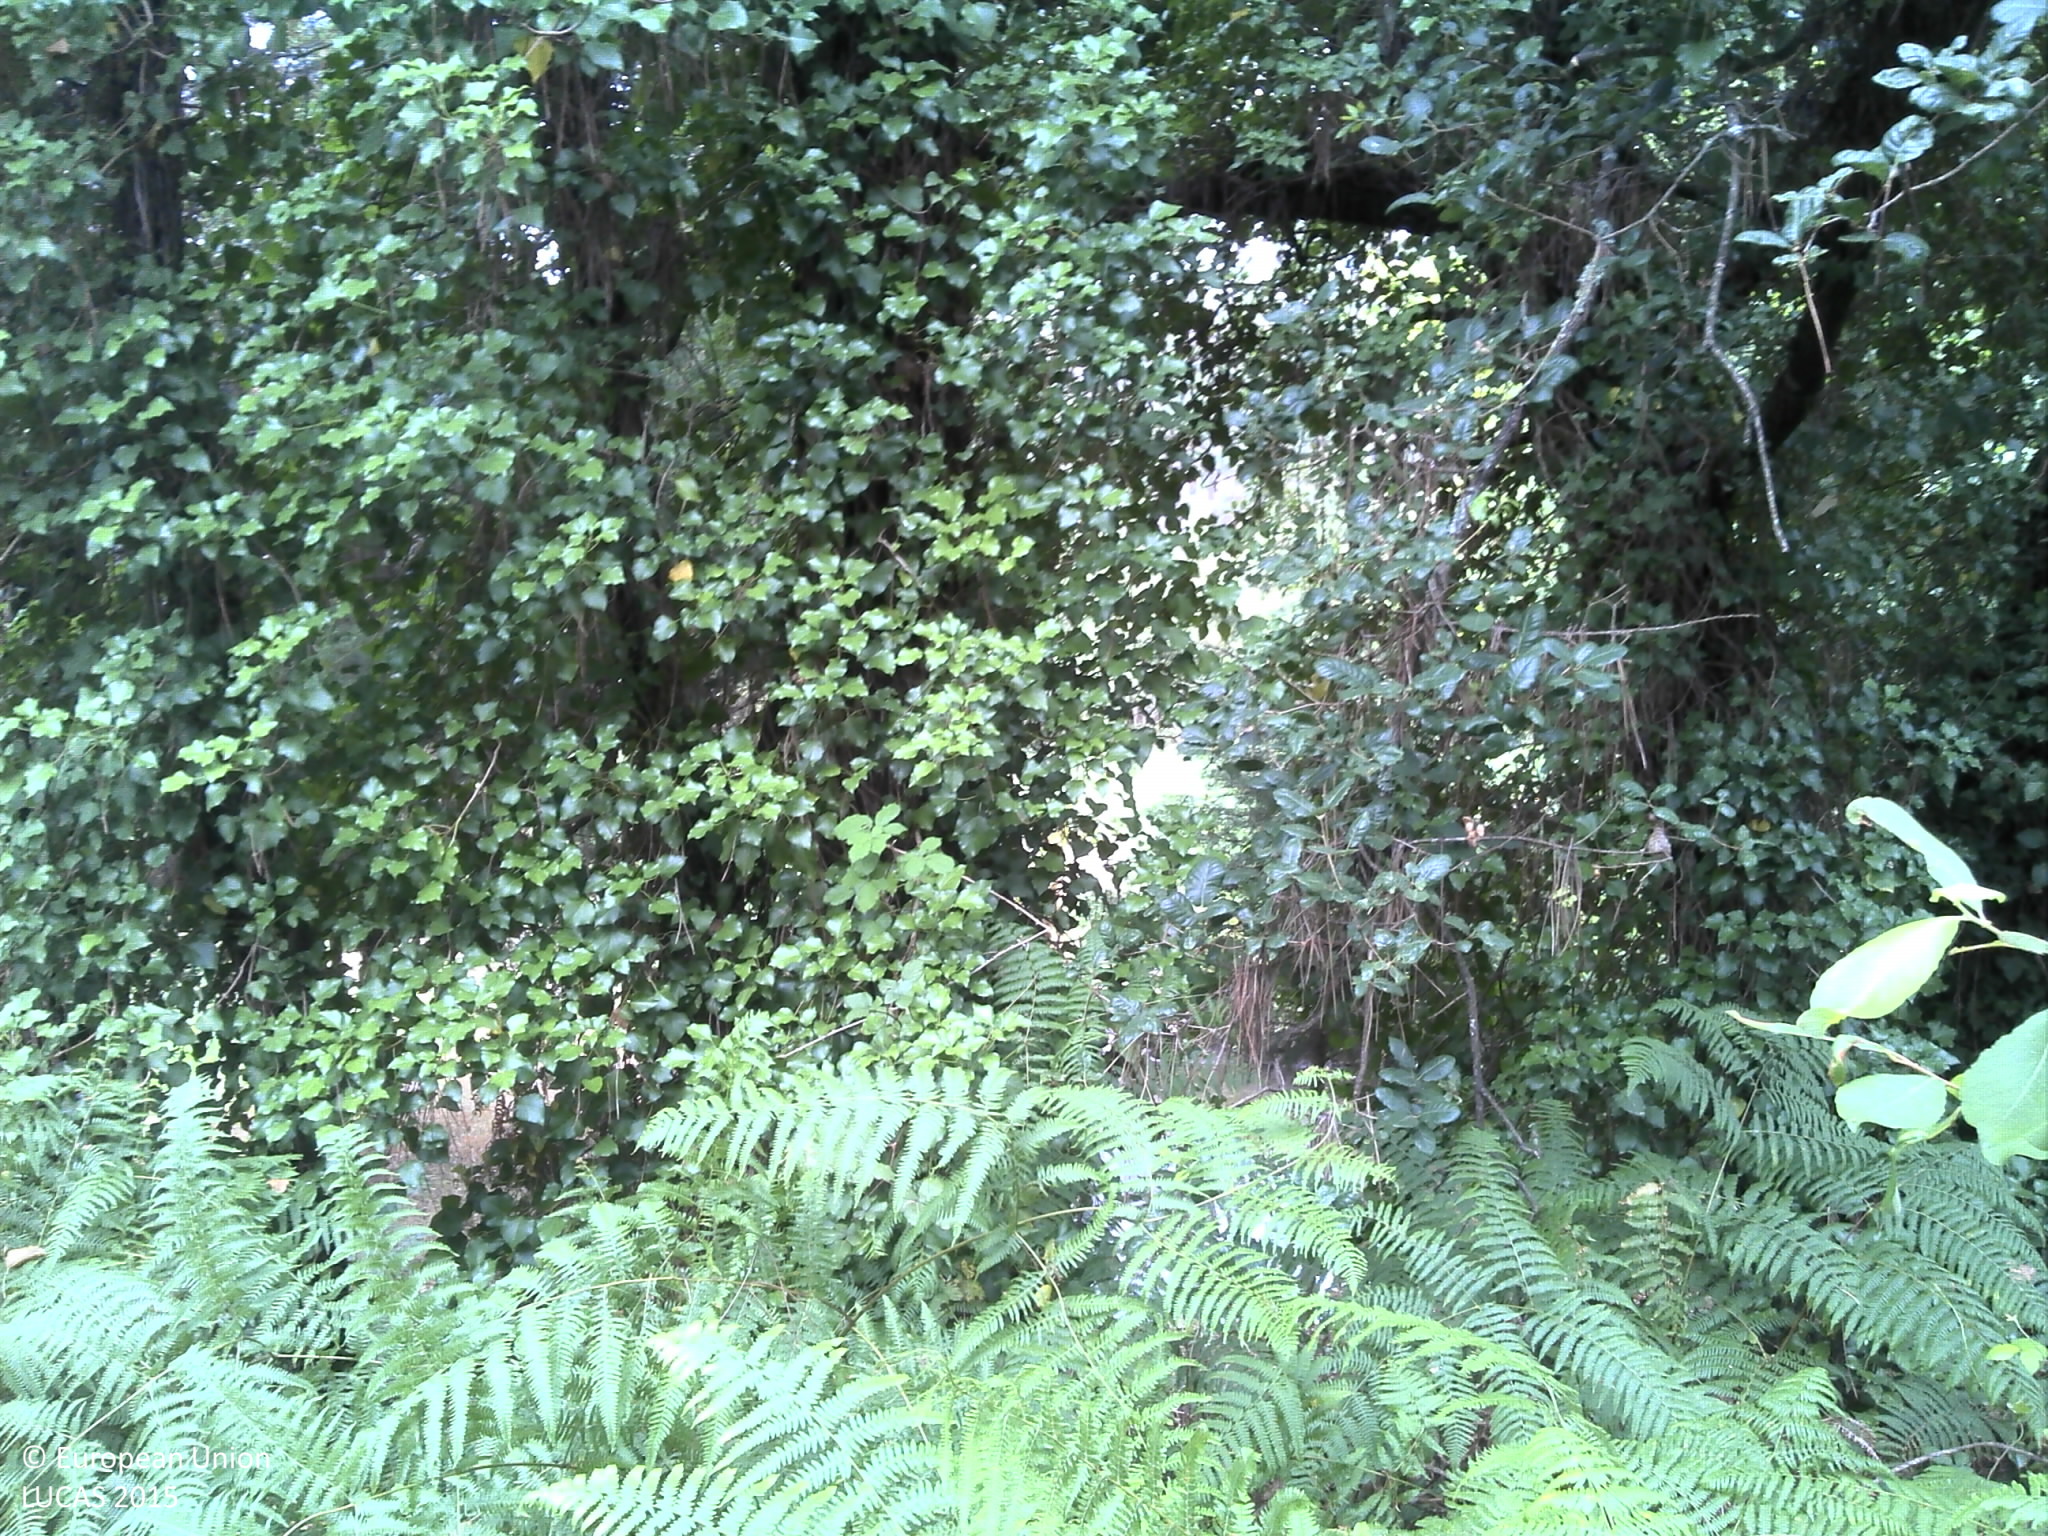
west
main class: Woodland
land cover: Pine dominated coniferous woodland
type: coniferous forest of the mediterranean region
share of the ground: 50 - 75 %
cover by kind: coniferous forest trees 60 %, shrubs 25 %, unconsolidated bare surface 15 %
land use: Forestry
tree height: > 5 m
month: June
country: PT
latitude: 40.2682
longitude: -8.6835
